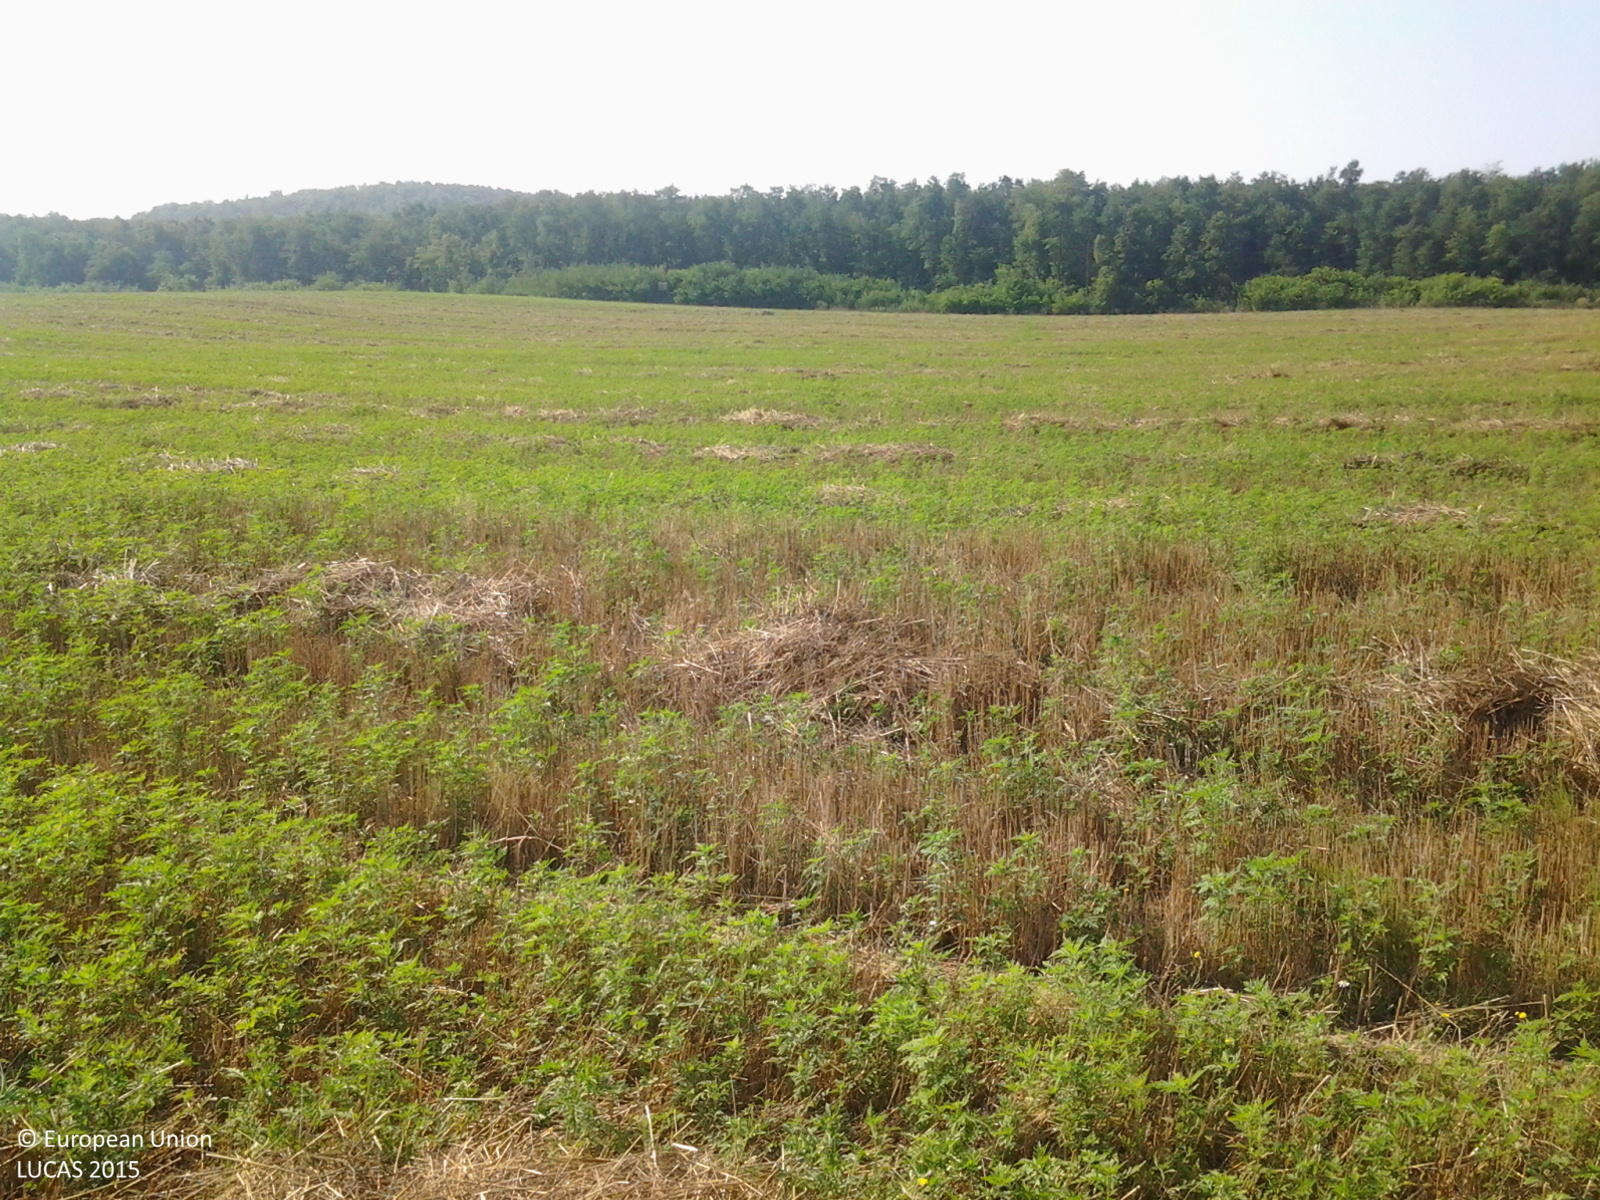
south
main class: Cropland
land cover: Durum wheat
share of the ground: 10 - 25 %
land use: Agriculture (excluding fallow land and kitchen gardens)
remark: Harvested field
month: August
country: HU
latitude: 46.3968
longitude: 18.2148
